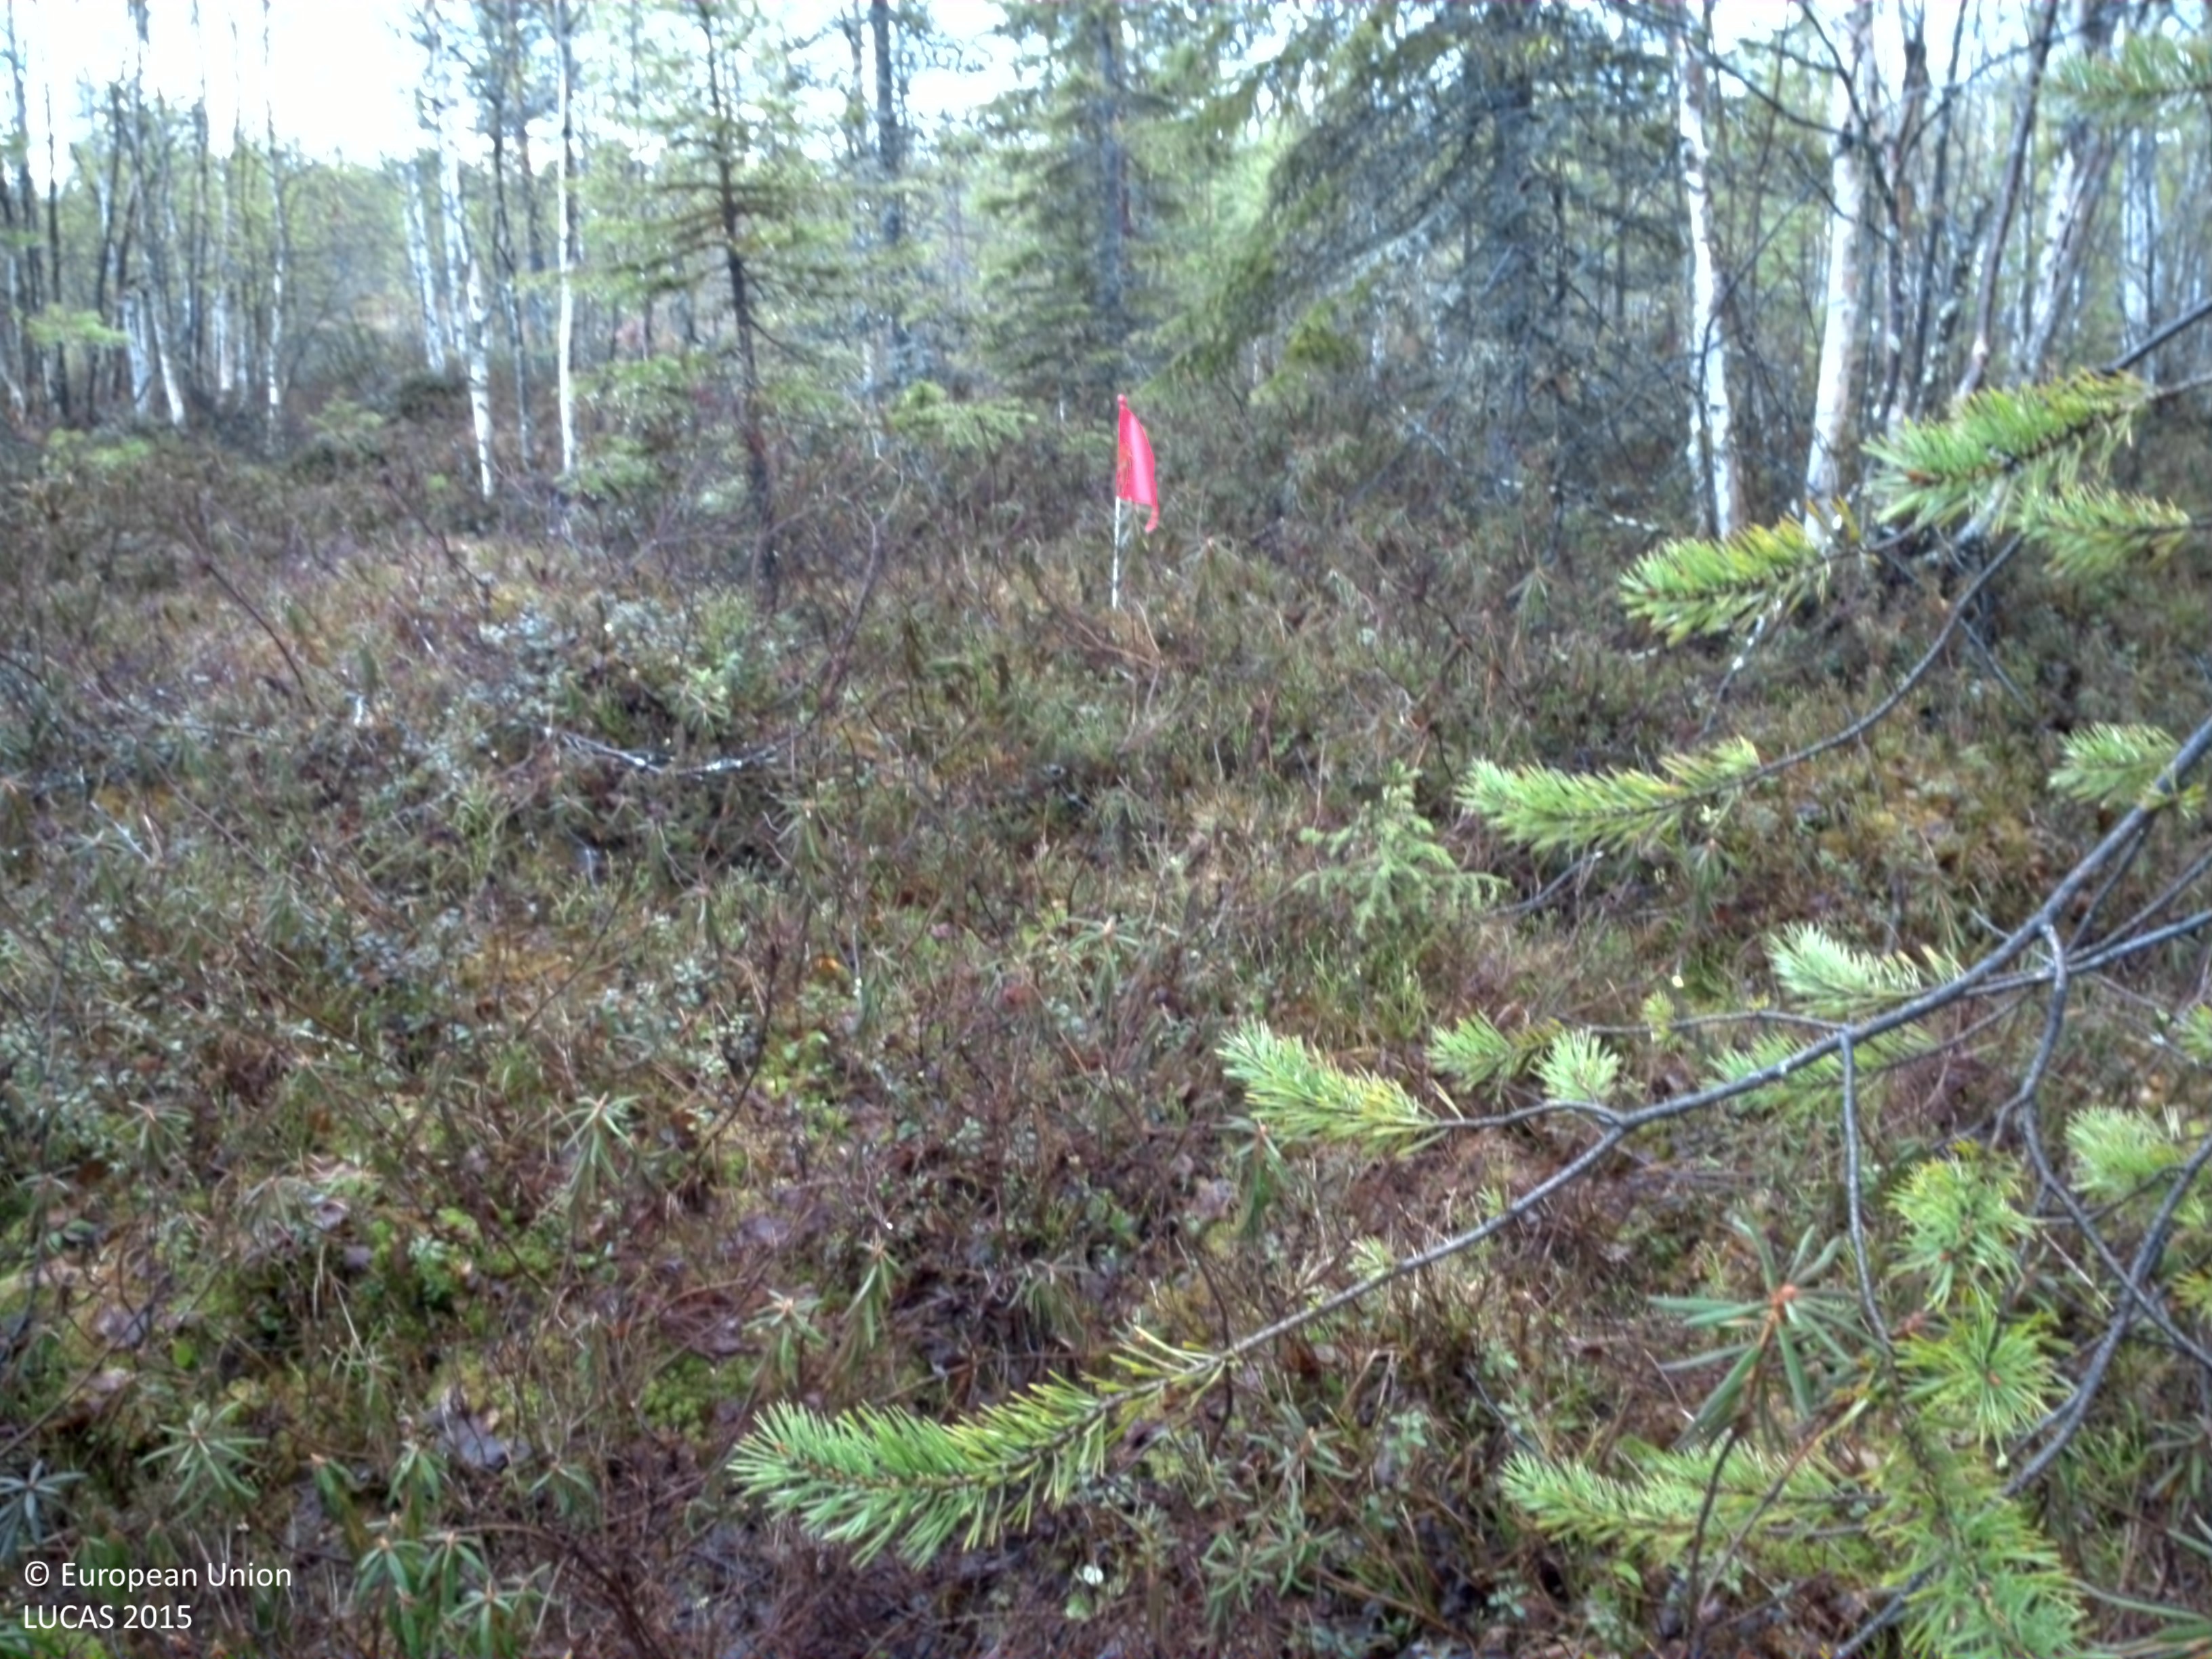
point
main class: Woodland
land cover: Pine dominated mixed woodland
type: boreal forest
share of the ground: 50 - 75 %
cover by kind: shrubs 40 %, coniferous forest trees 25 %, broadleaved forest trees 25 %, lichens and mosses 10 %
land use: Forestry
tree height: > 5 m
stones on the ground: 25 - 50 %
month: May
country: SE
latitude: 66.2185
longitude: 23.1619
